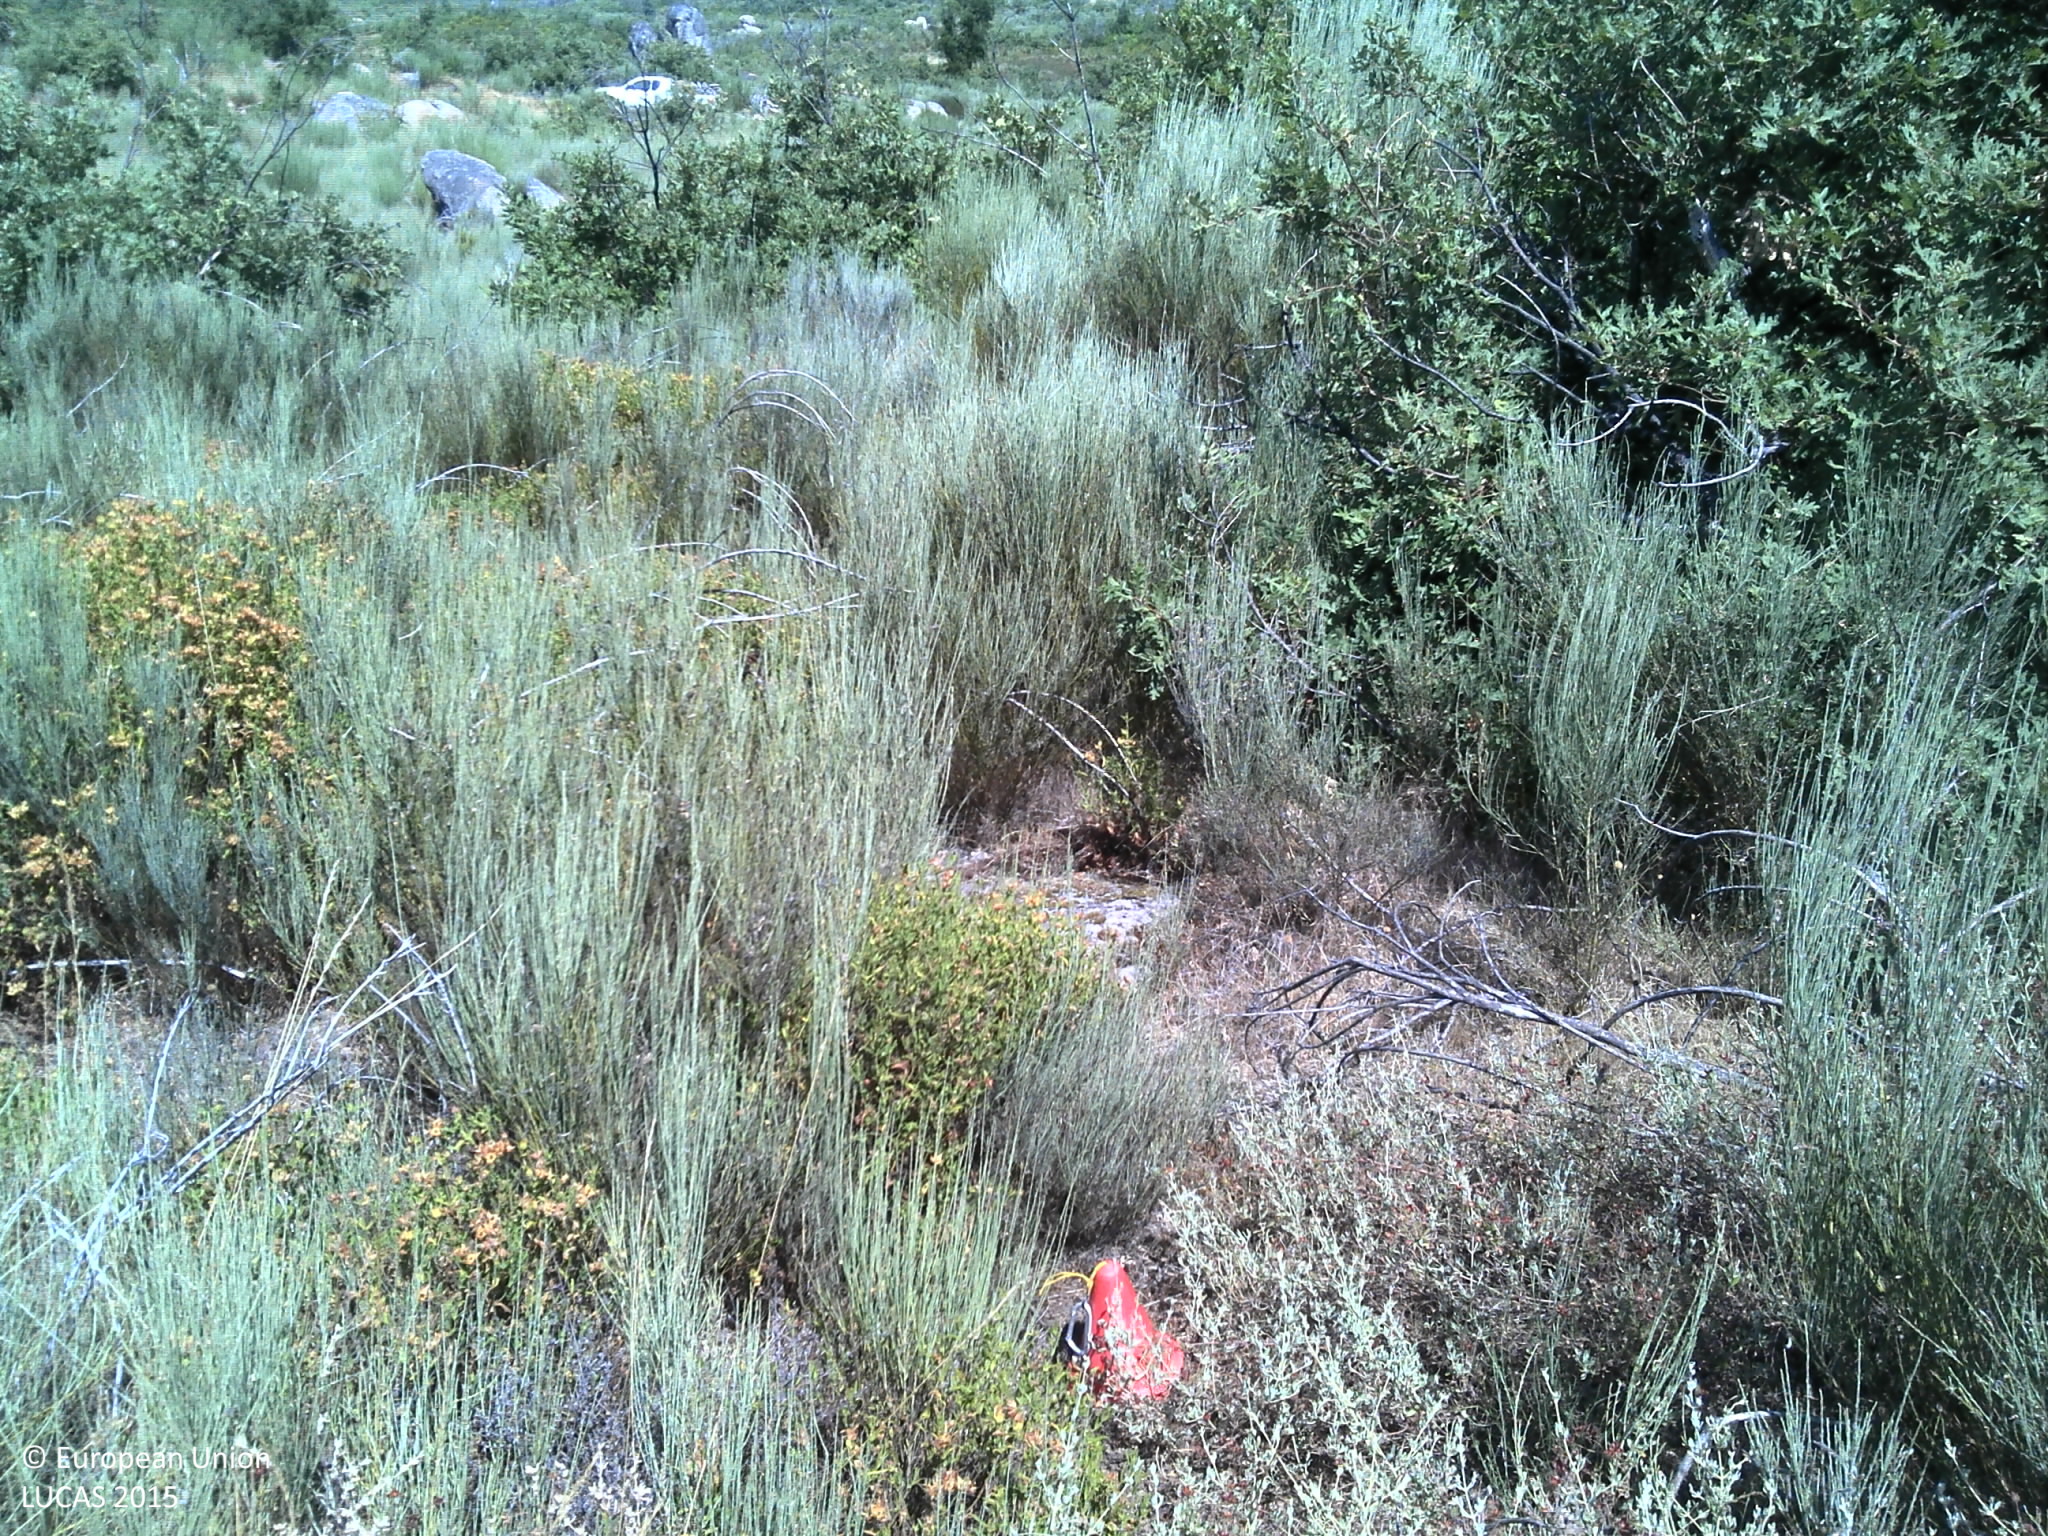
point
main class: Shrubland
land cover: Shrubland with sparse tree cover
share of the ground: > 75 %
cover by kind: shrubs 75 %, herbaceous plants 15 %, broadleaved forest trees 5 %, consolidated bare surface 5 %
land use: Agriculture (excluding fallow land and kitchen gardens)
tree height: < 5 m
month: July
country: PT
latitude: 41.7514
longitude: -7.5585
